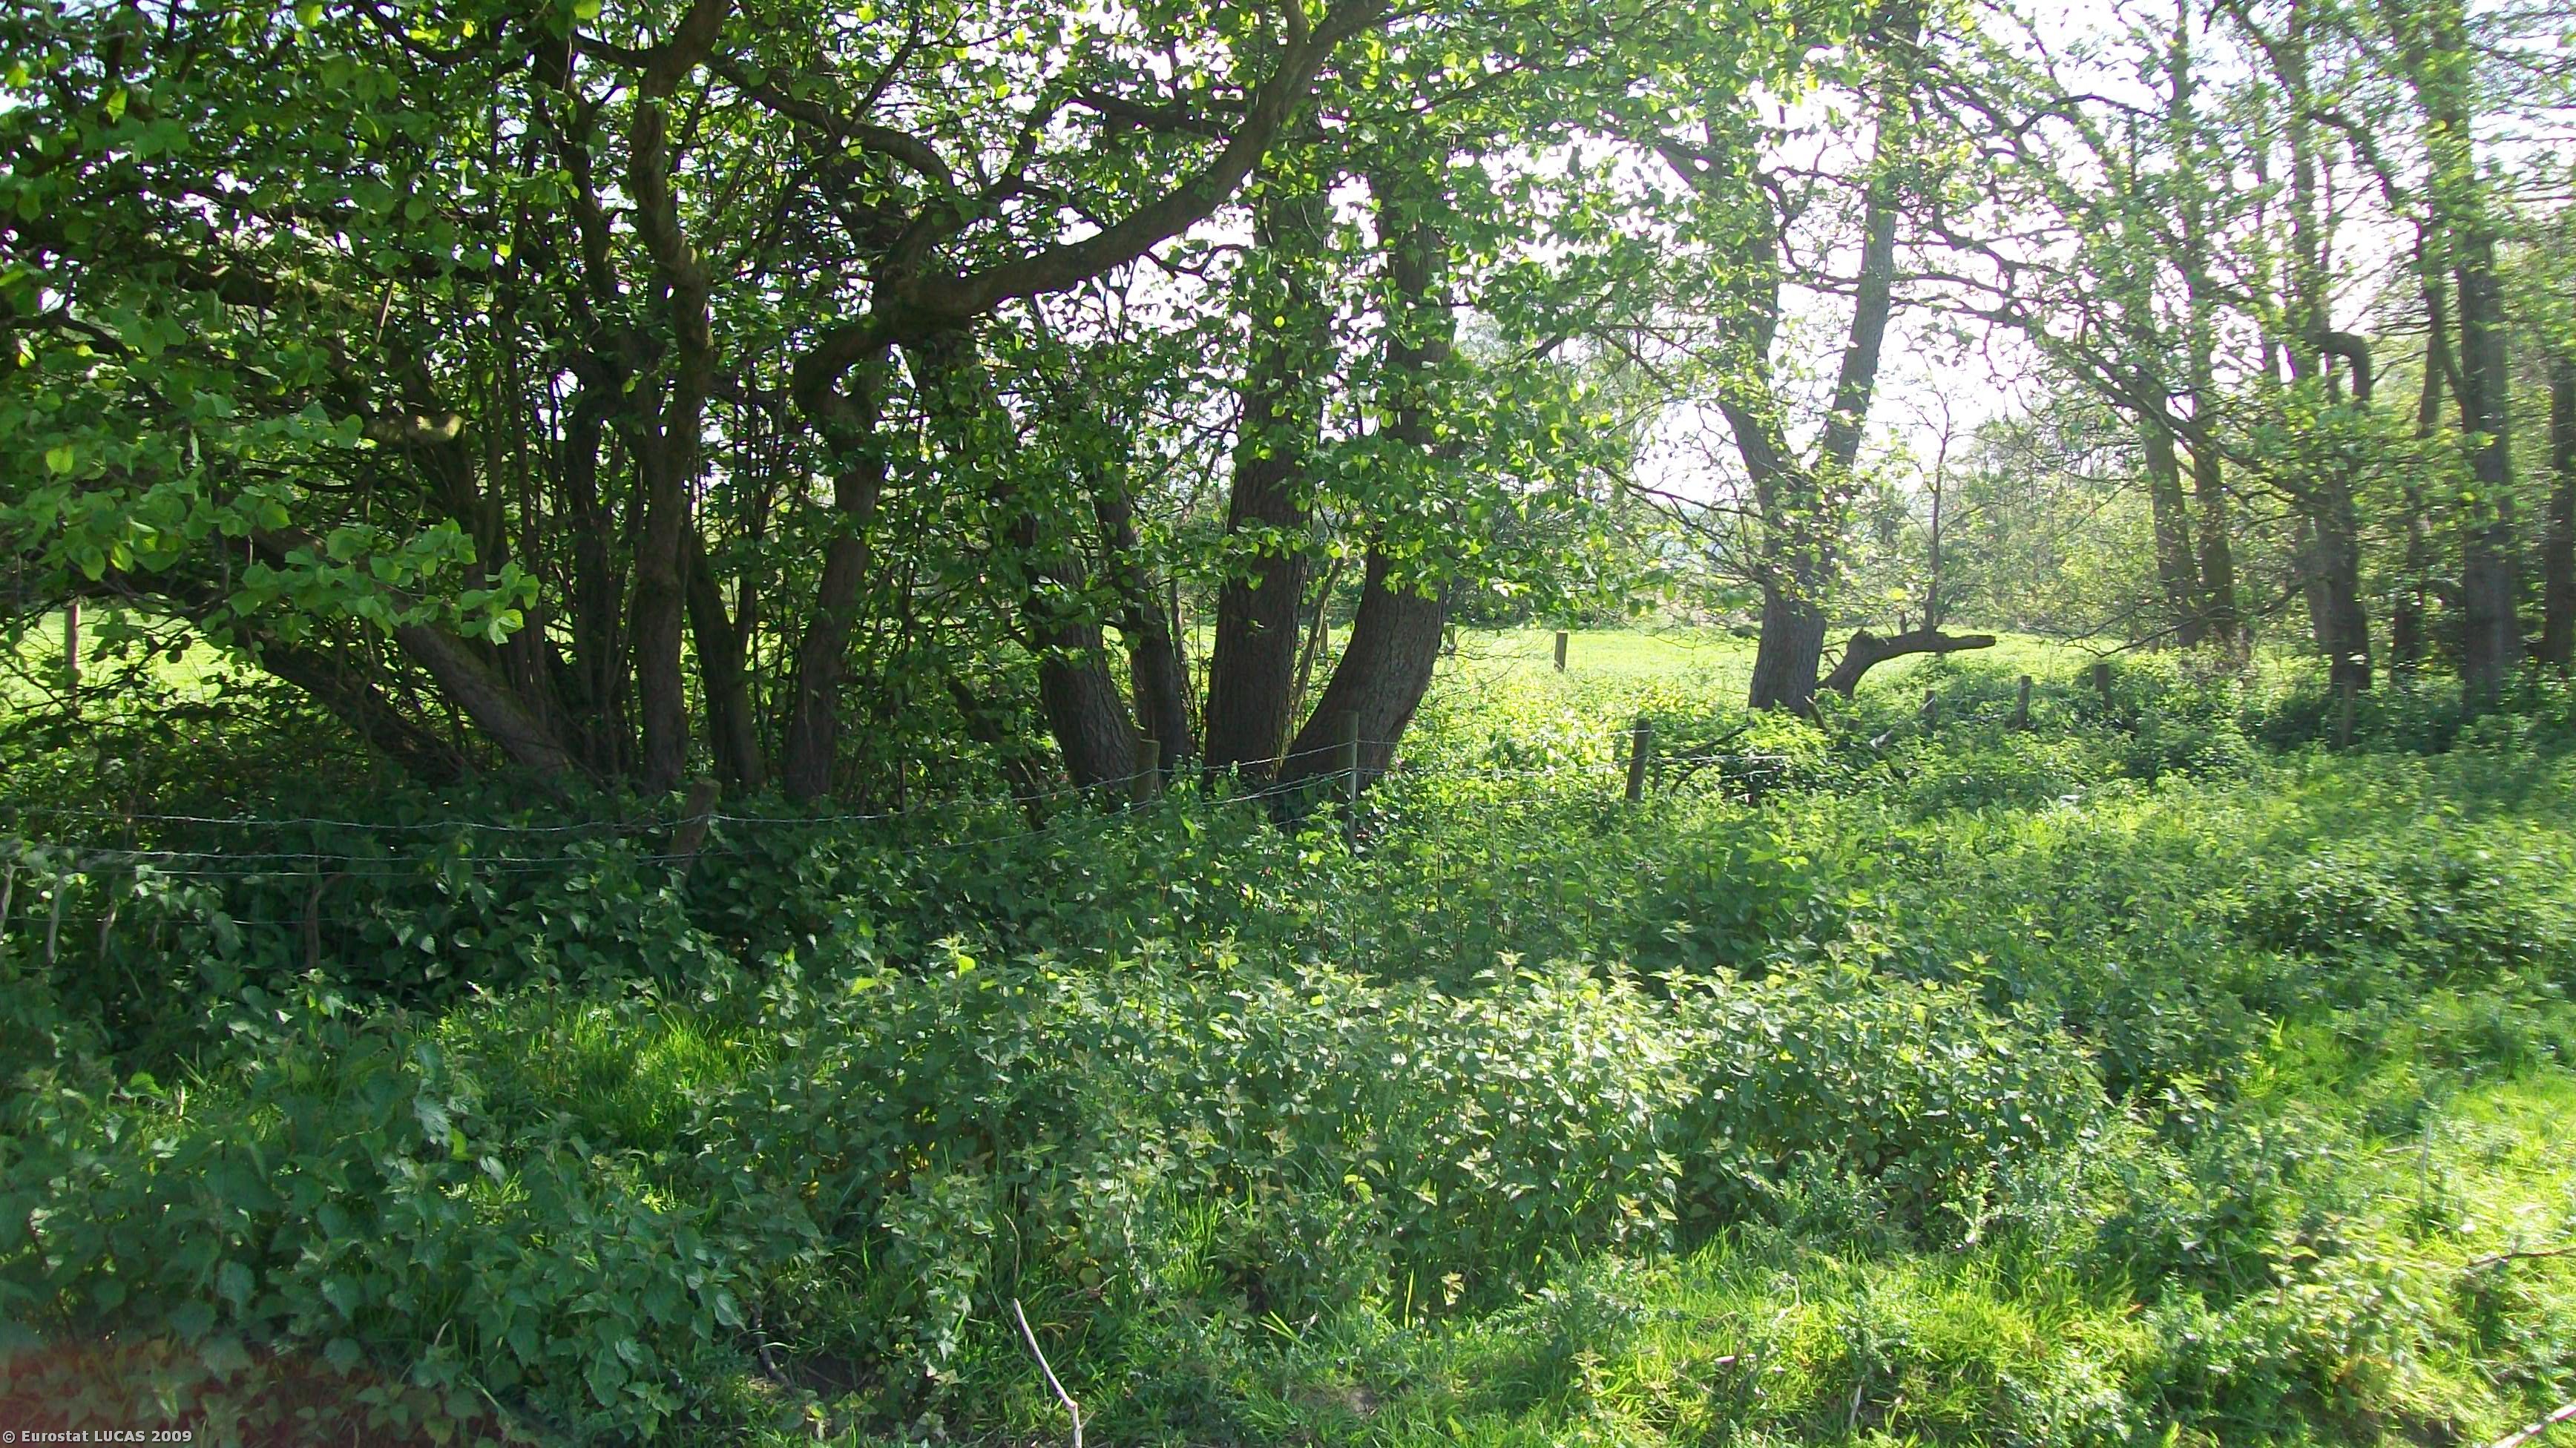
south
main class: Grassland
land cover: Grassland without tree/shrub cover
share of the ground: > 75 %
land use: Agriculture (excluding fallow land and kitchen gardens)
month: May
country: GB
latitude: 53.1690
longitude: -3.3498
